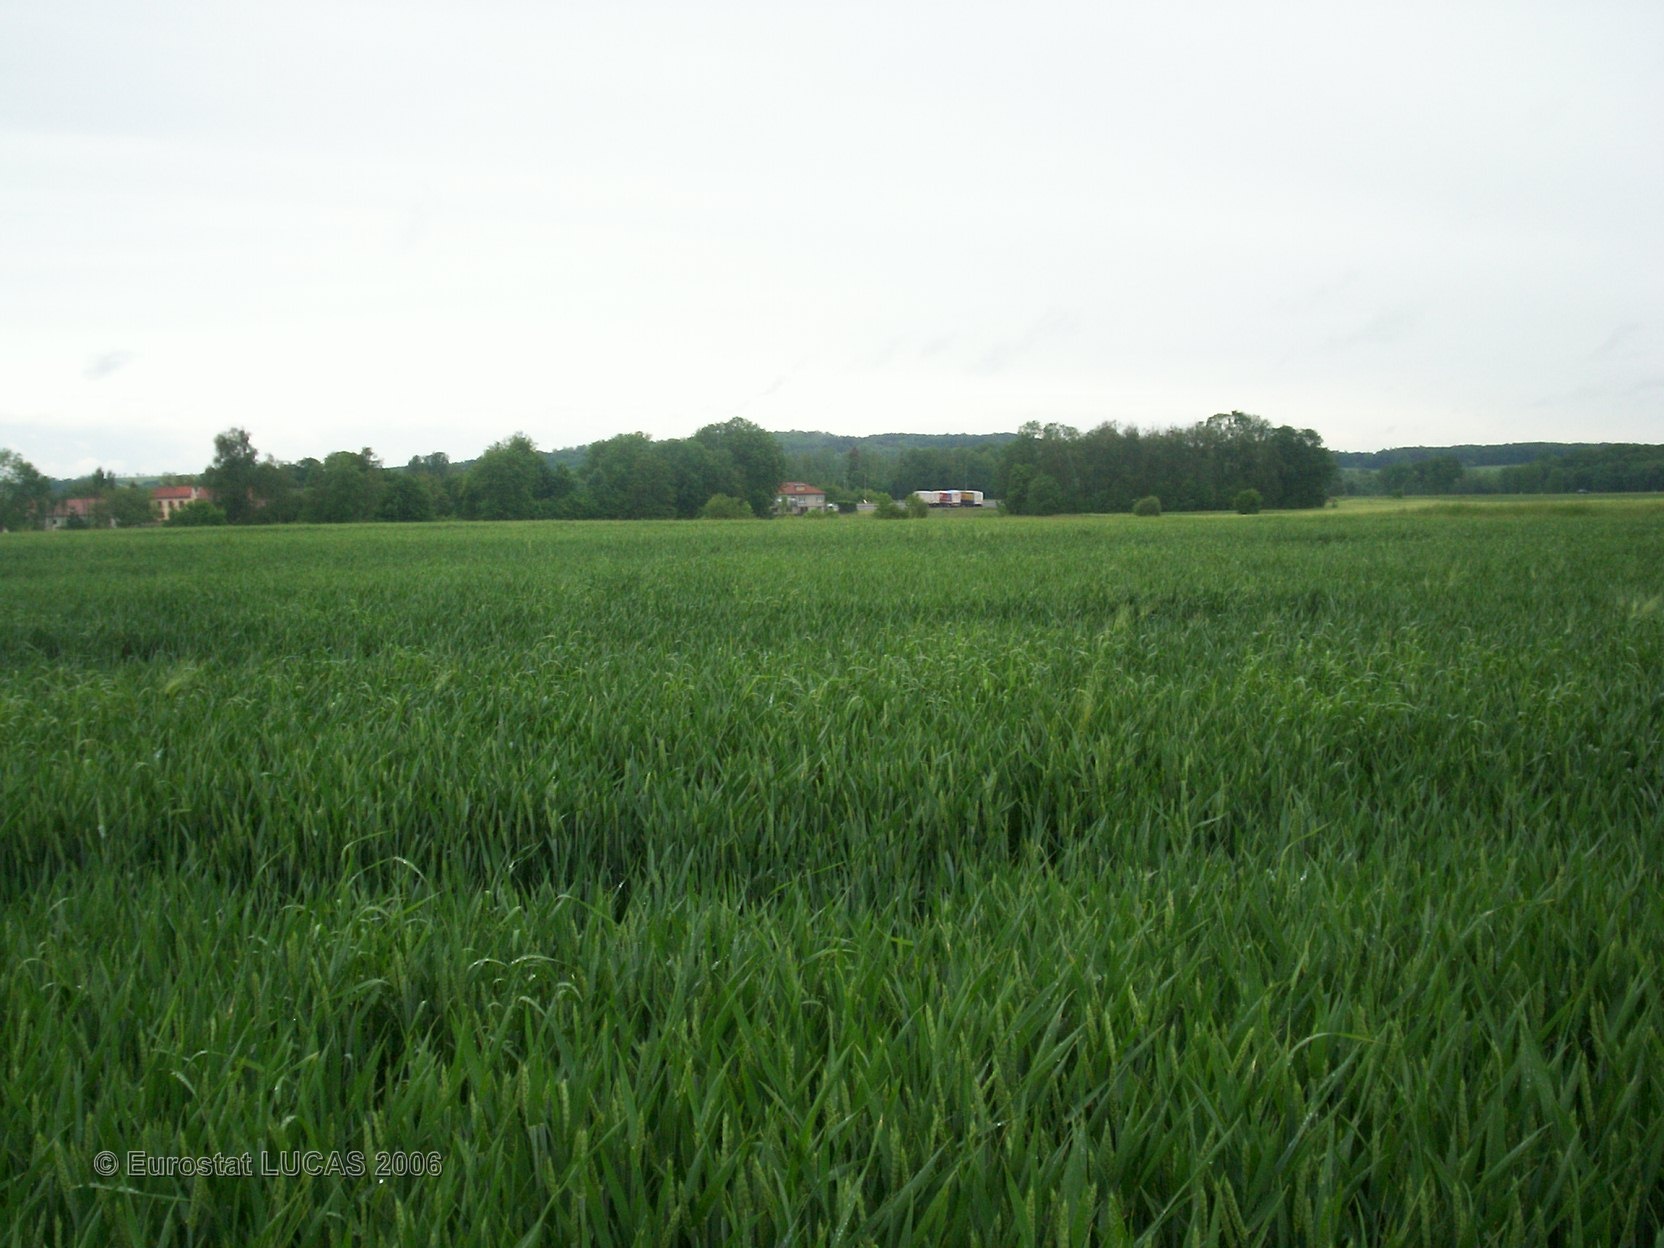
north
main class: Cropland
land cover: Common wheat
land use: Agriculture (excluding fallow land and kitchen gardens)
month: May
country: FR
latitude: 48.5542
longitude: 6.7626
